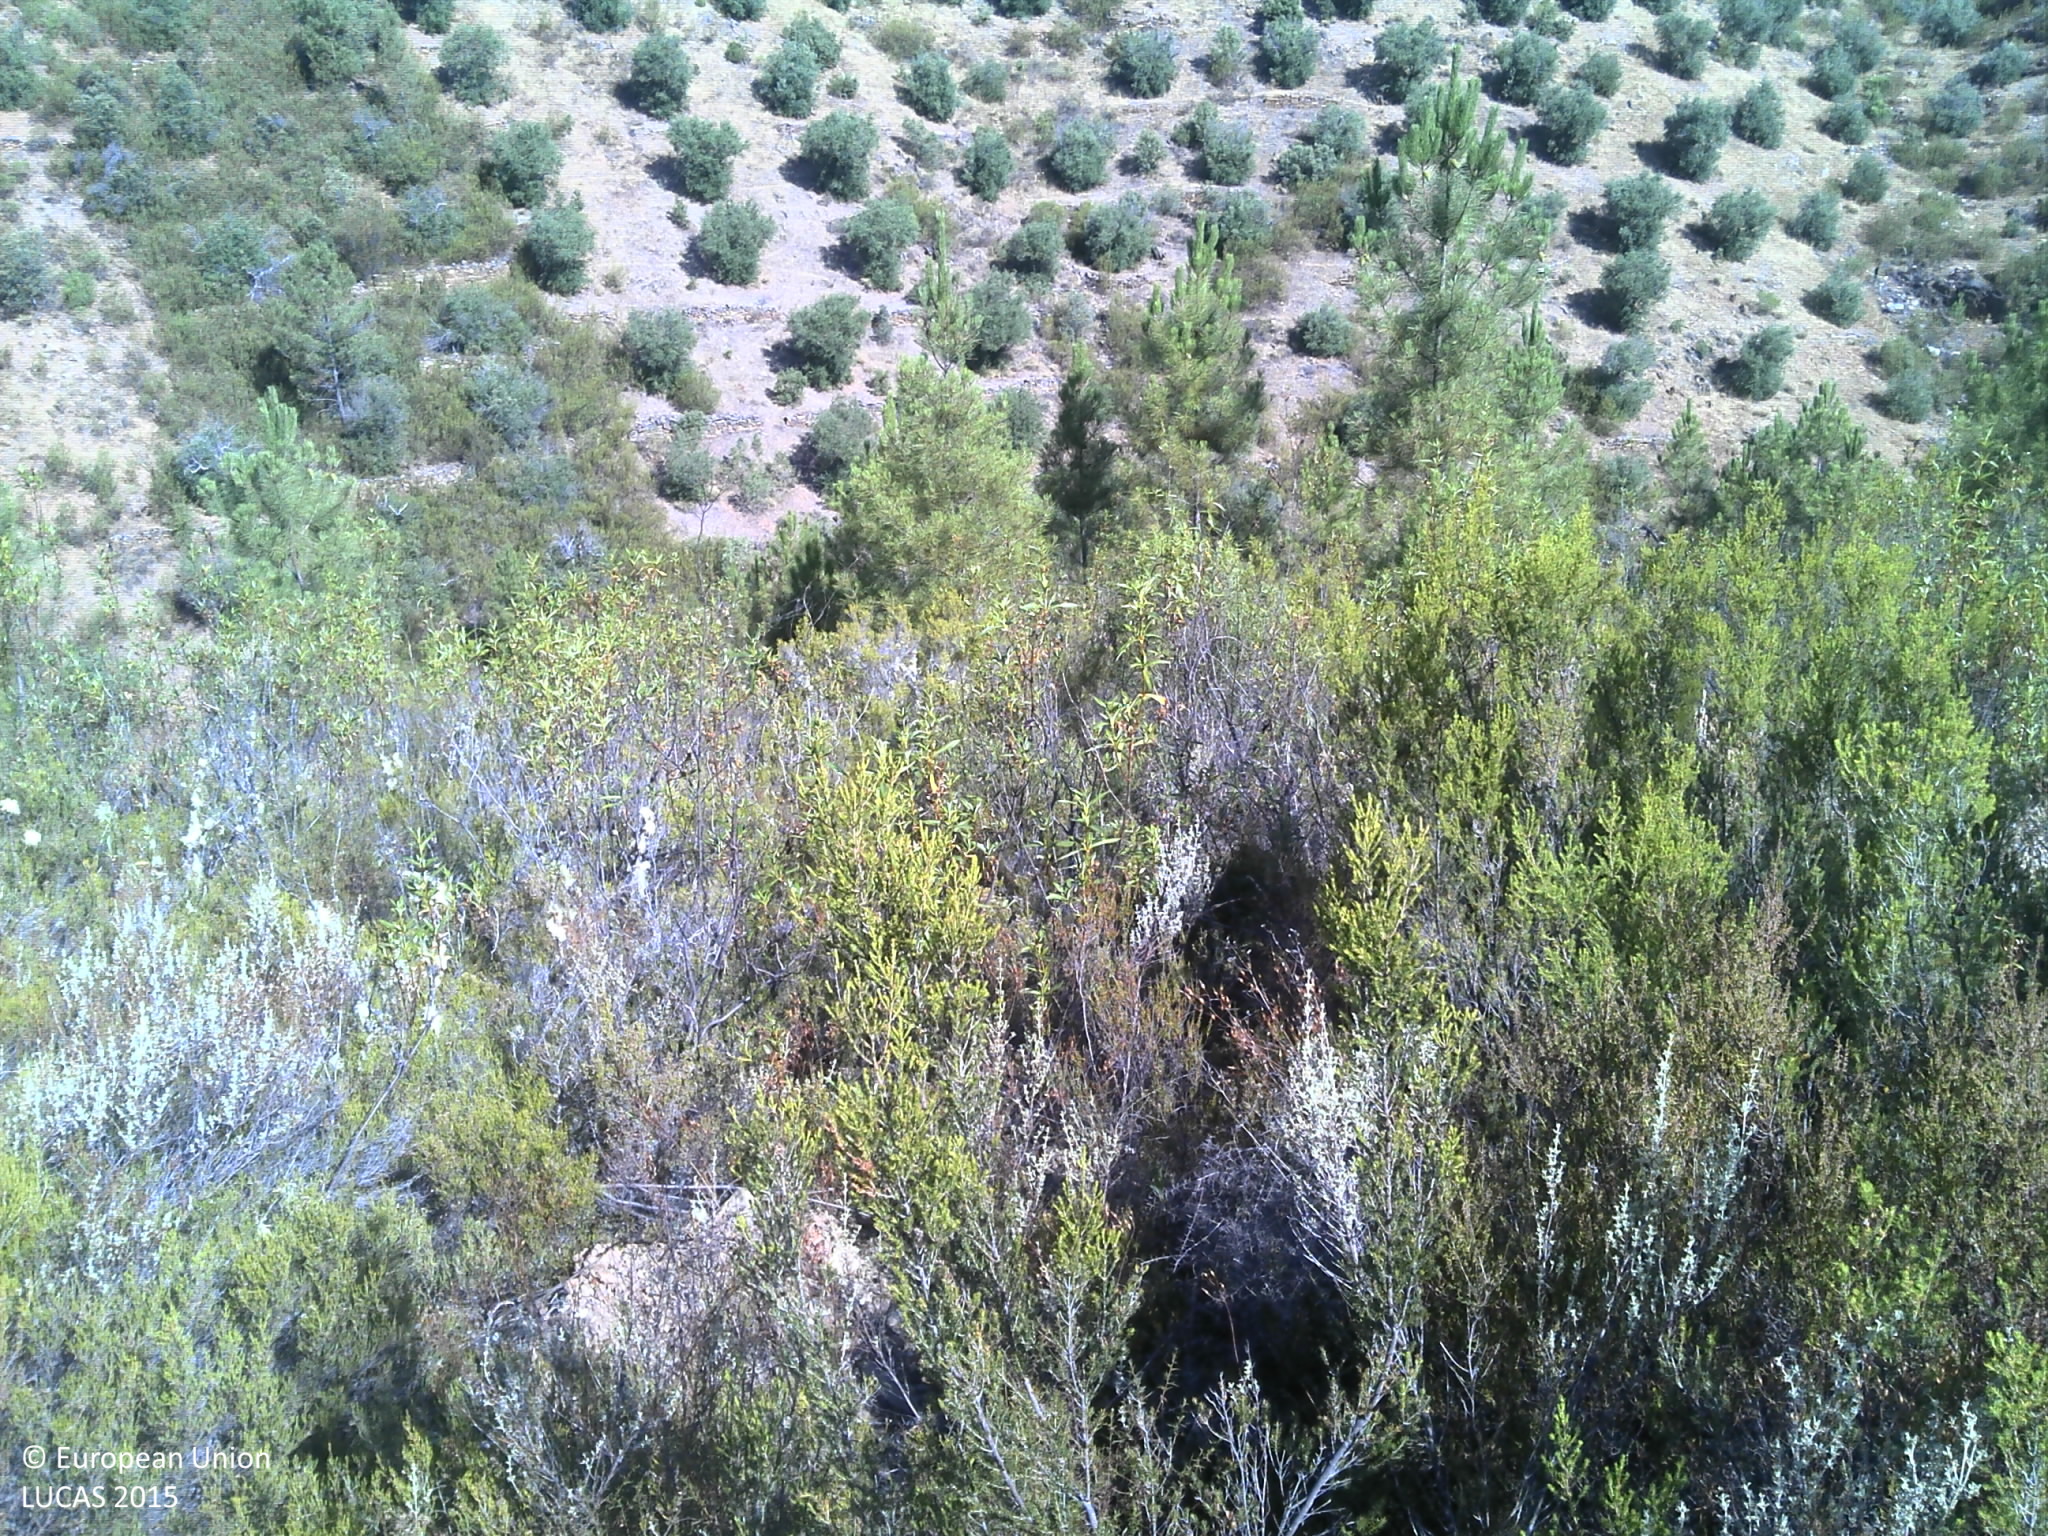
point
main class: Shrubland
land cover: Shrubland with sparse tree cover
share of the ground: 50 - 75 %
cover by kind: shrubs 75 %, unconsolidated bare surface 10 %, coniferous forest trees 5 %, herbaceous plants 5 %
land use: Forestry
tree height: < 5 m
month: July
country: PT
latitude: 39.8226
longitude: -7.6150
